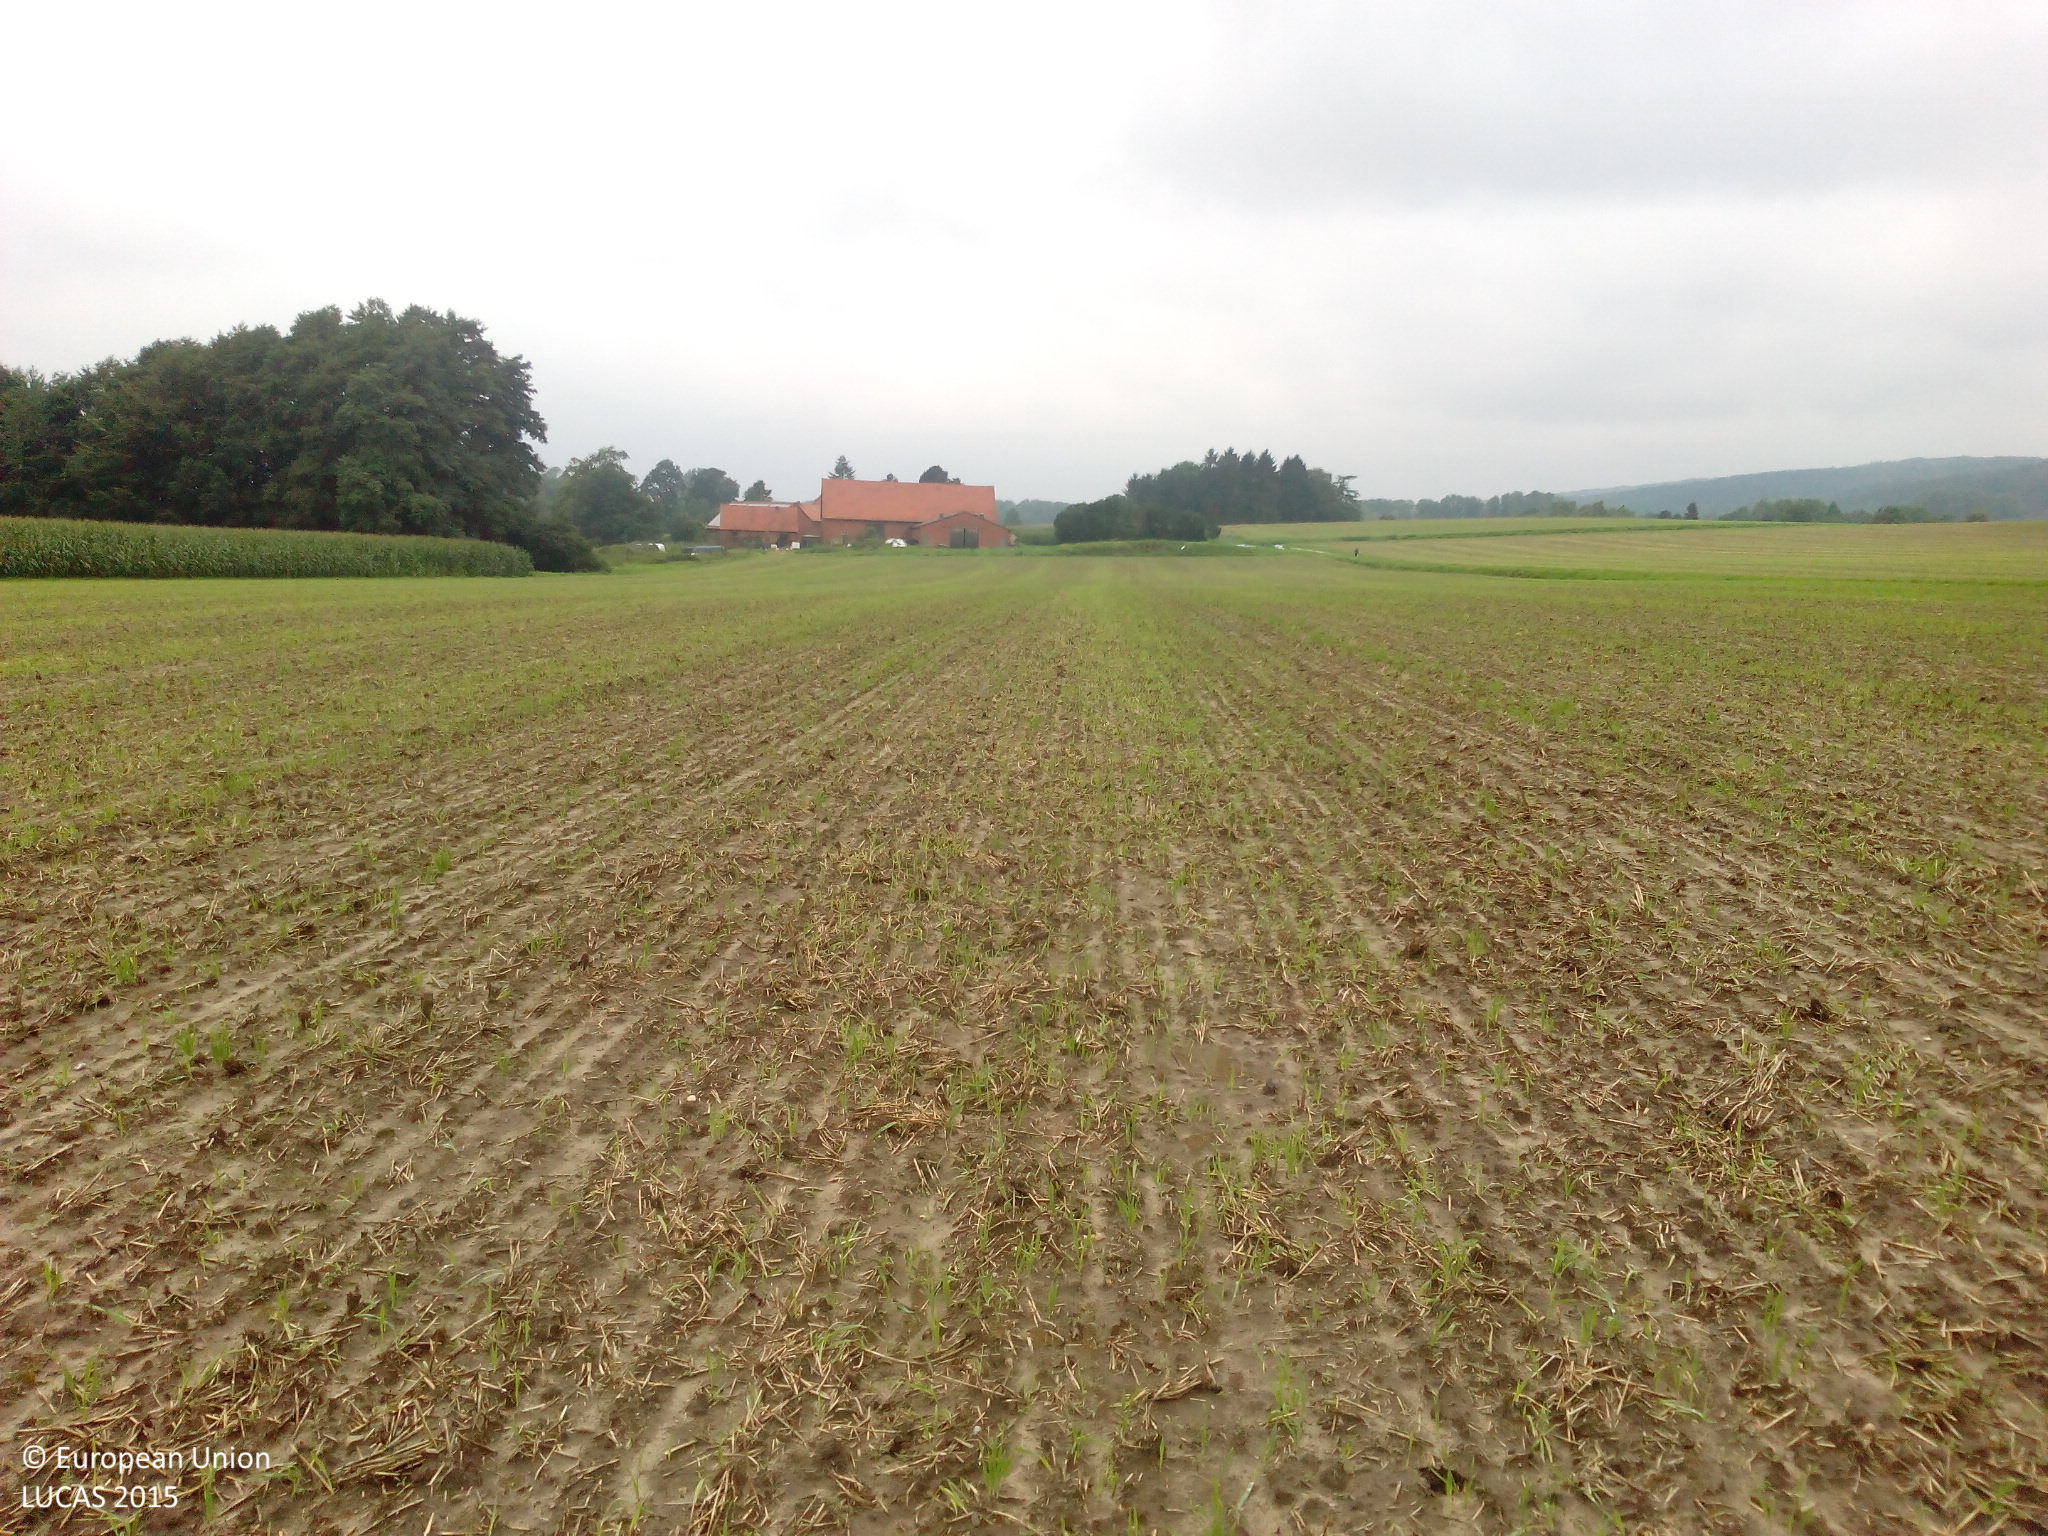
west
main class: Grassland
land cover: Spontaneously vegetated surfaces
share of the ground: 25 - 50 %
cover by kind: unconsolidated bare surface 75 %, herbaceous plants 25 %
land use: Agriculture (excluding fallow land and kitchen gardens)
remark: Harvested field
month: August
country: DE
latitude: 52.1454
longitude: 8.0276
